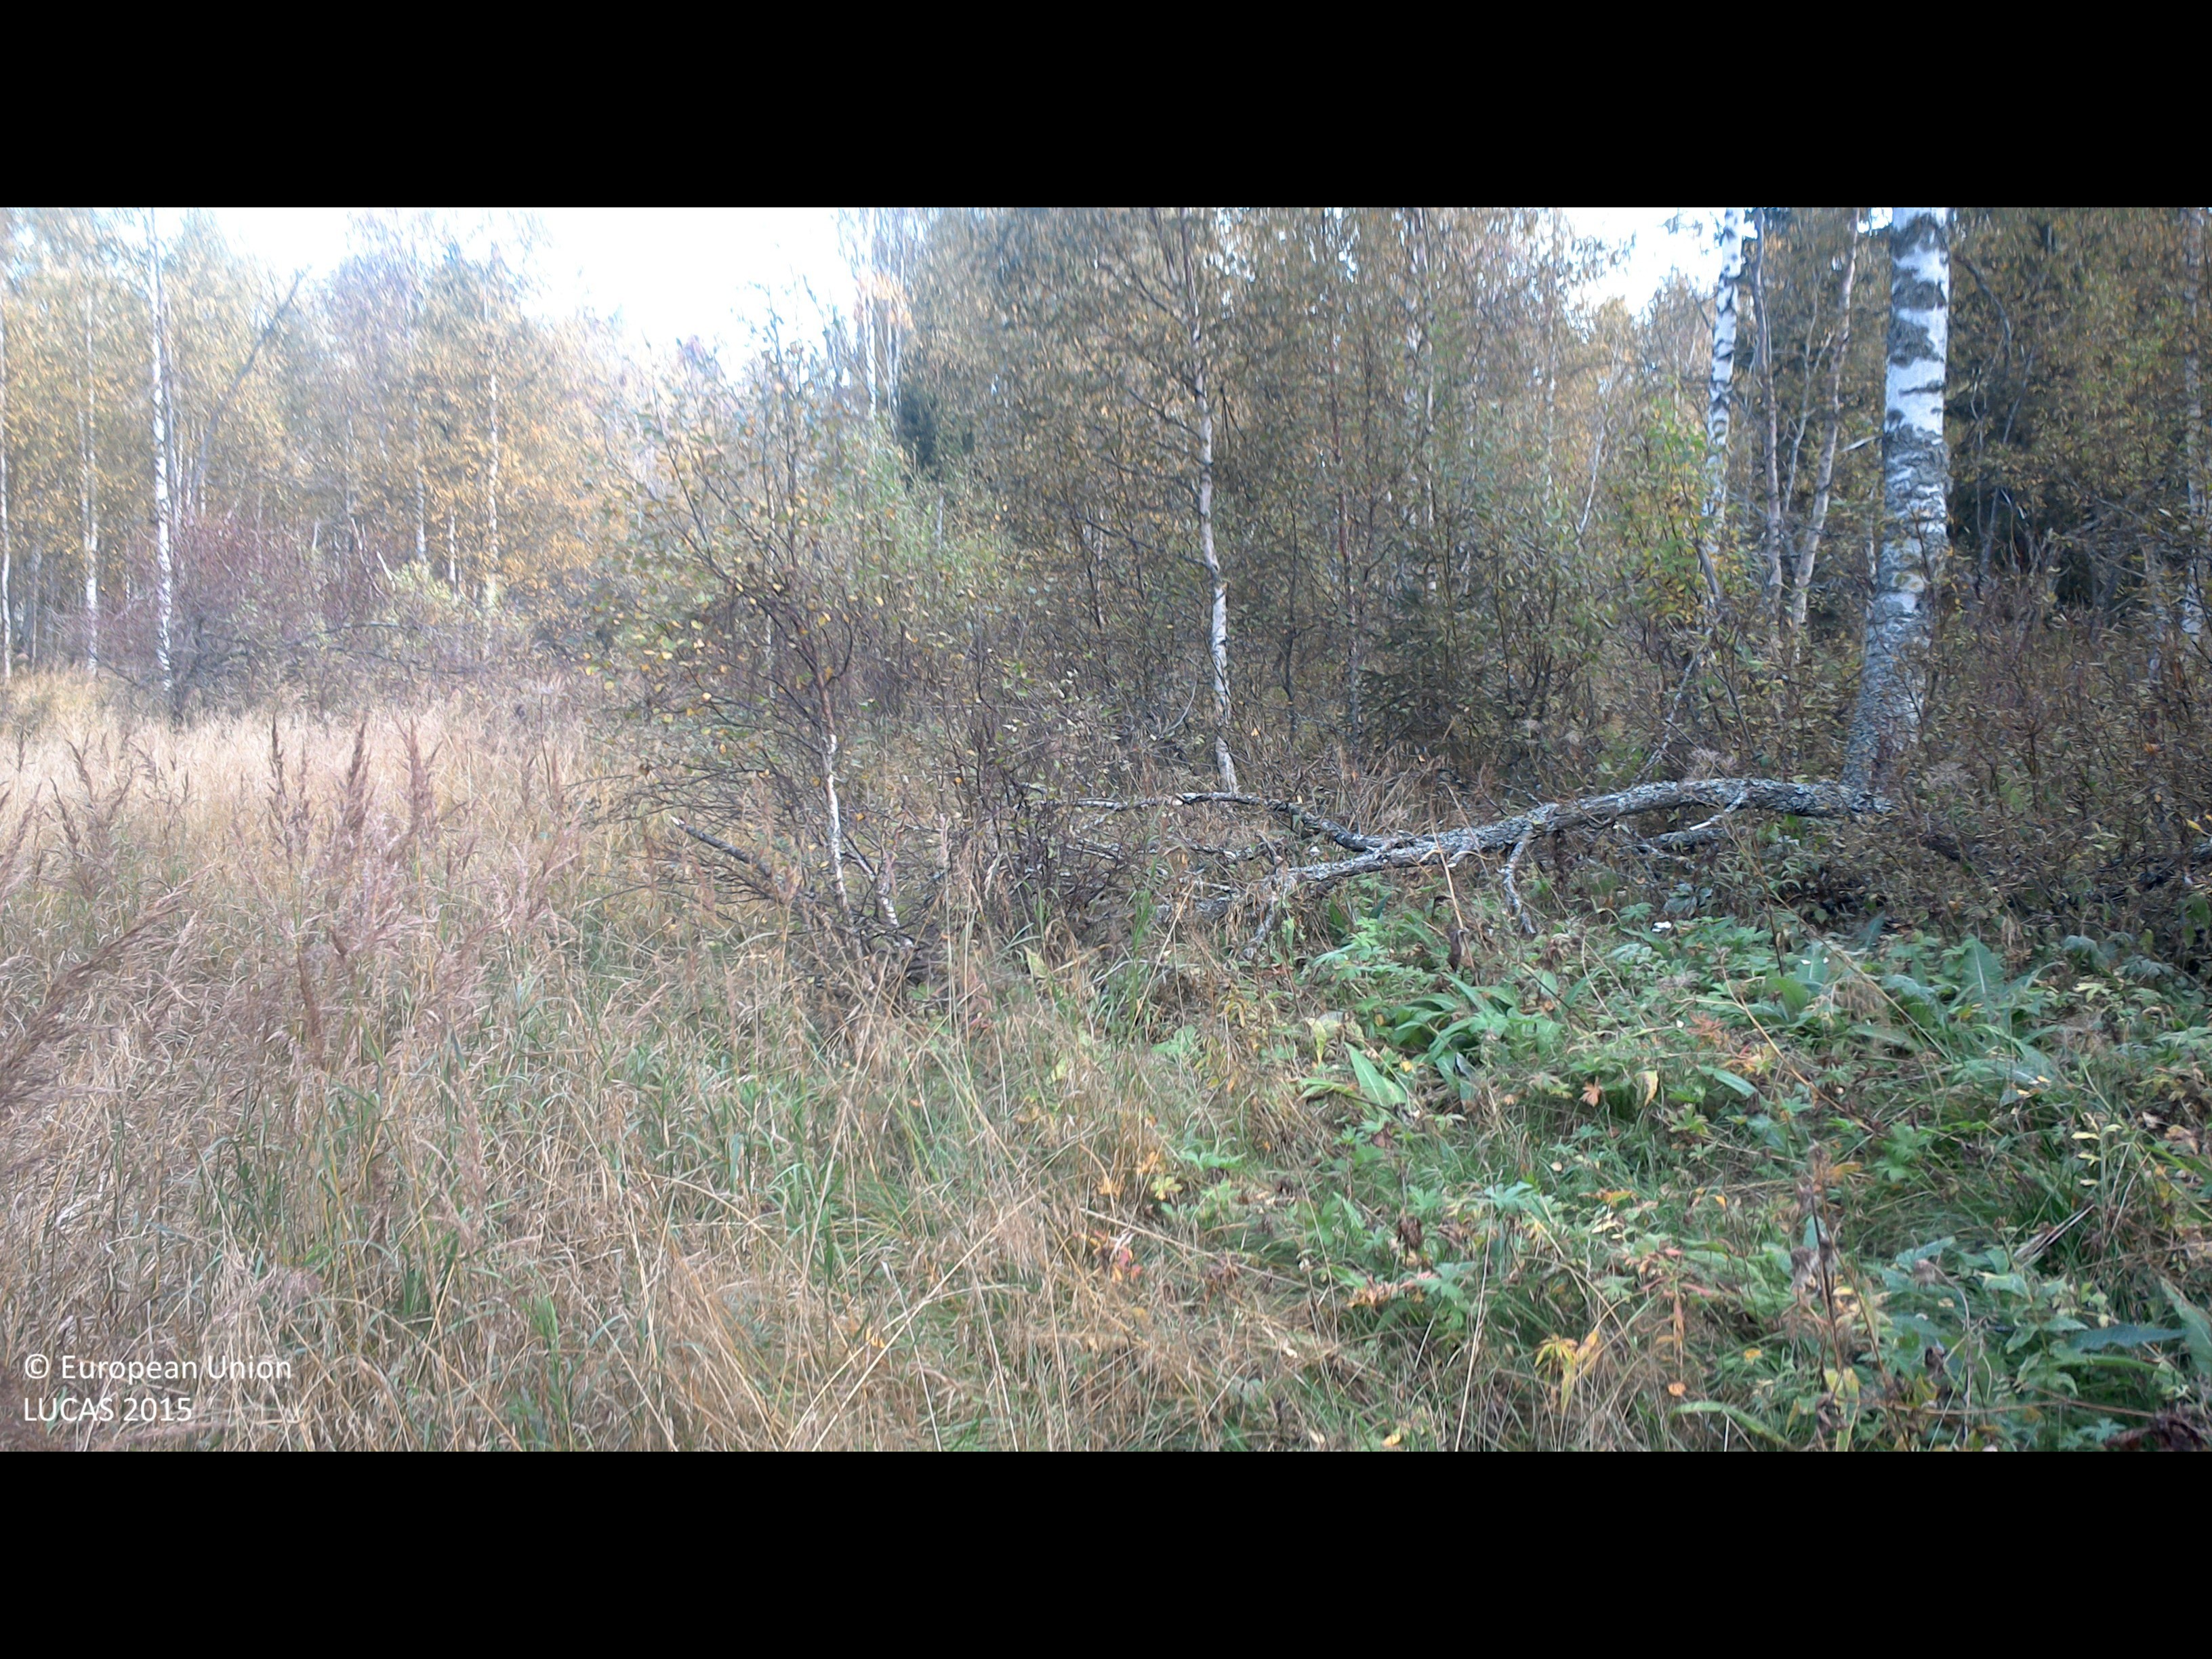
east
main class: Woodland
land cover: Broadleaved woodland
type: hemiboreal forest and nemoral coniferous forest and mixed broadleaved-coniferous forest
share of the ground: 25 - 50 %
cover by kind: broadleaved forest trees 50 %, shrubs 50 %
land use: Semi-natural and natural areas not in use
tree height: > 5 m
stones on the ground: < 10 %
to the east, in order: Broadleaved woodland; Inland marshes; Grassland with sparse tree/shrub cover; Broadleaved woodland; Inland fresh running water; Broadleaved woodland; Spruce dominated mixed woodland
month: September
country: SE
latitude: 63.9186
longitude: 19.9891
